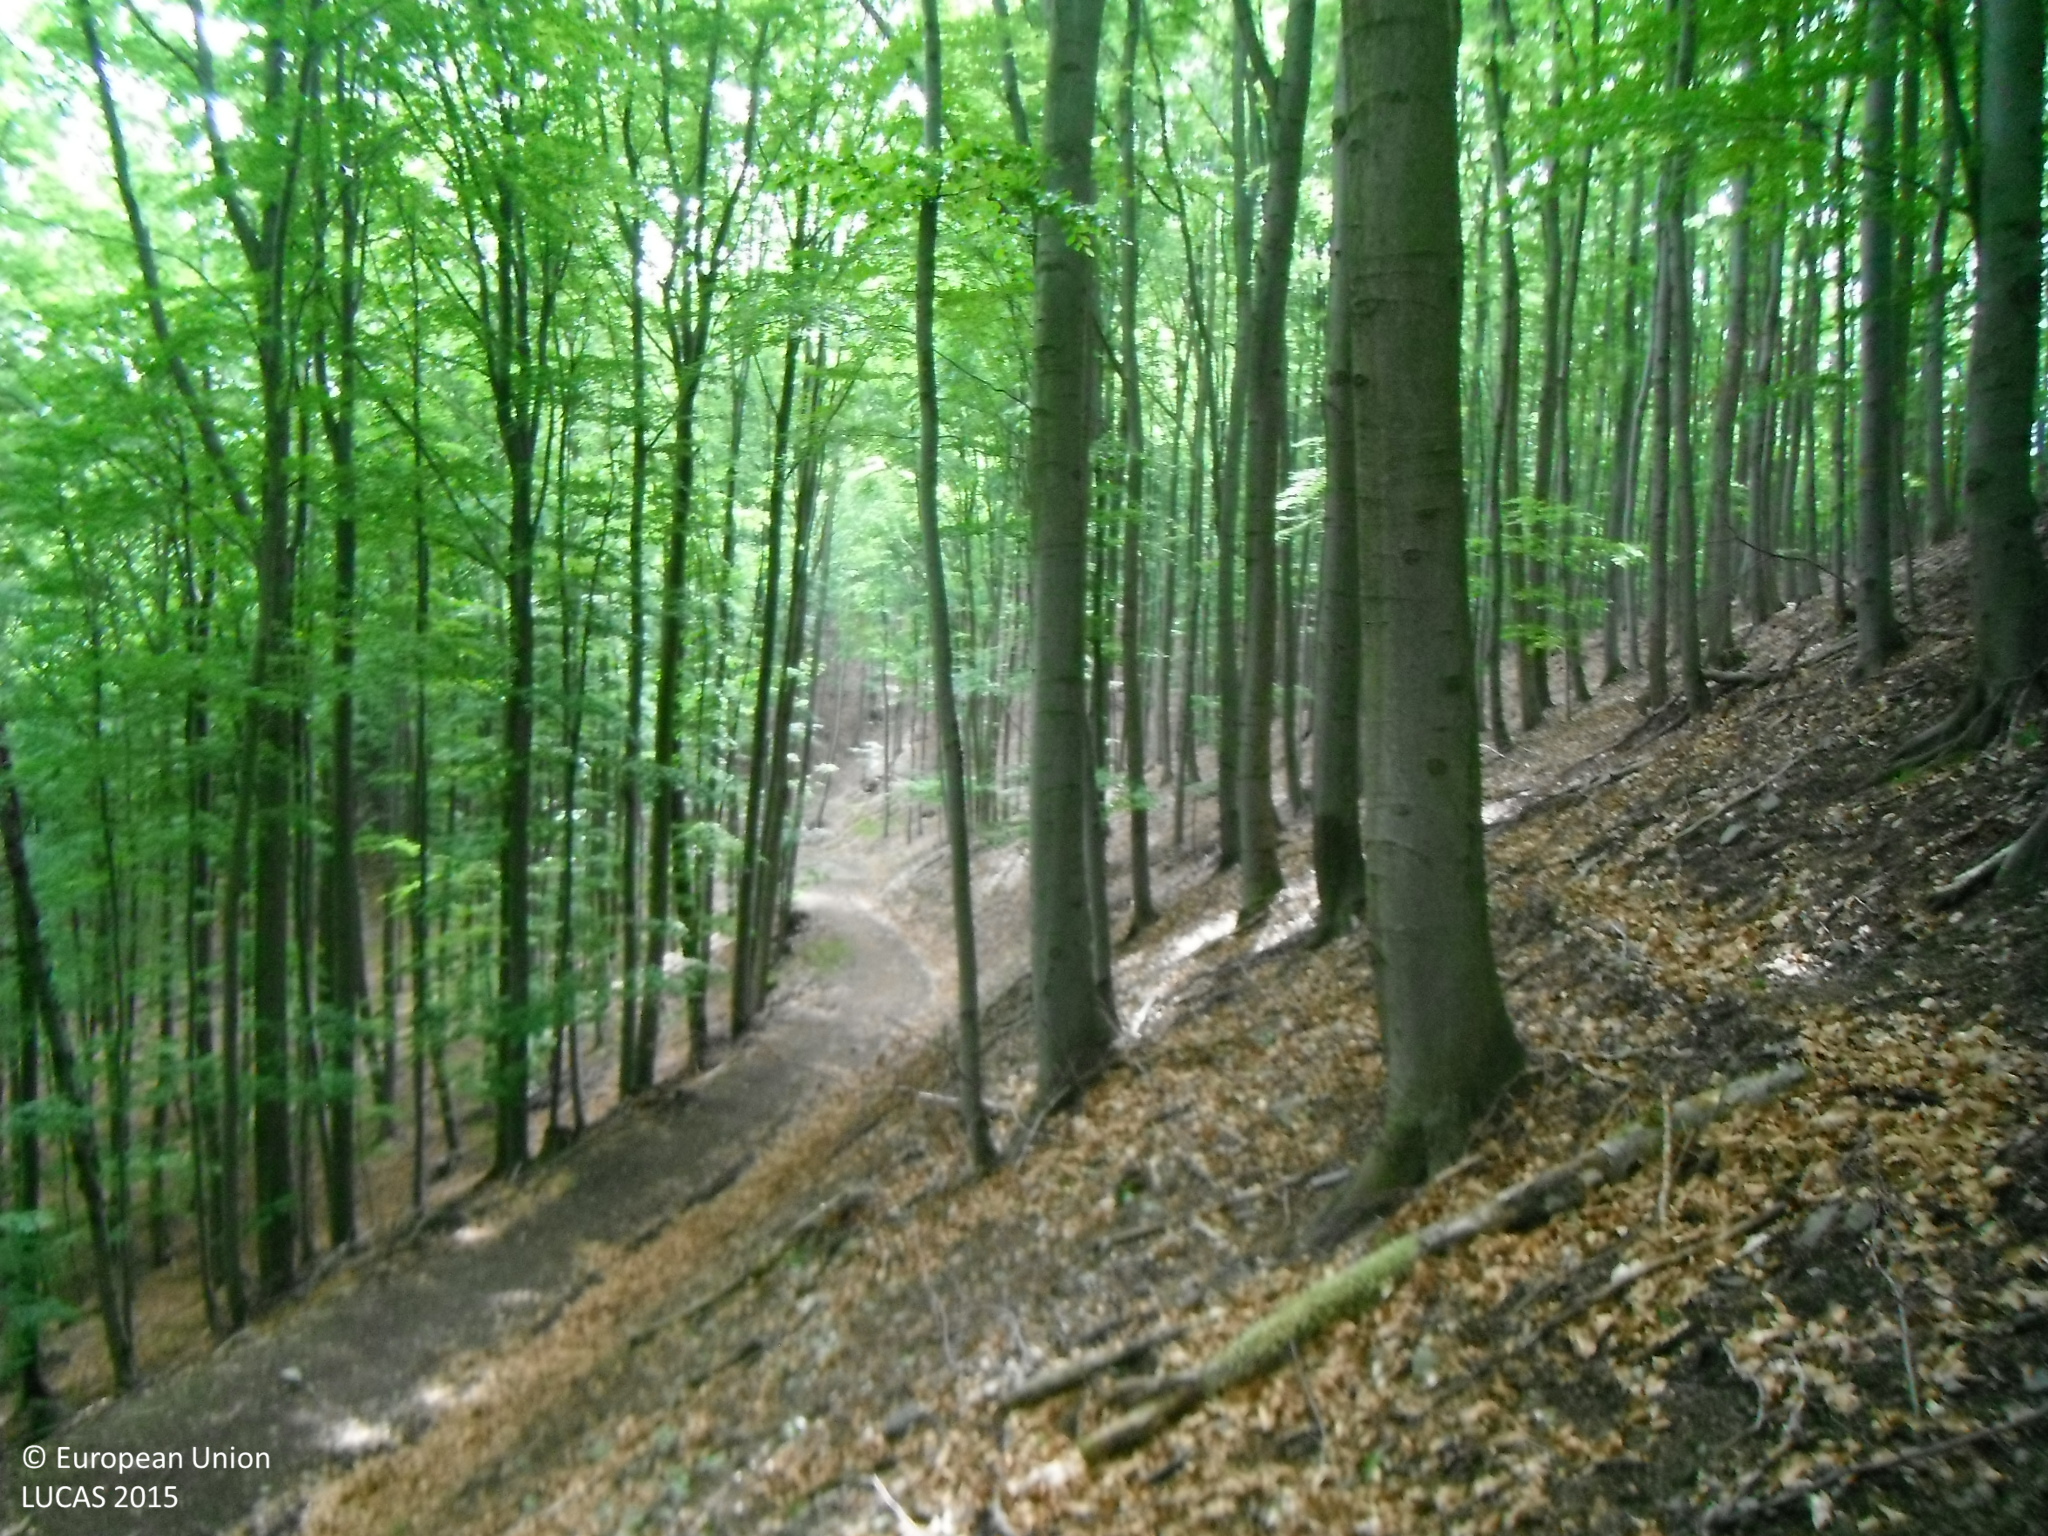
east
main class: Woodland
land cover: Broadleaved woodland
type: mountainous beech forest
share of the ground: > 75 %
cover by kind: broadleaved forest trees 100 %
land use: Forestry
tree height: > 5 m
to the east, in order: Broadleaved woodland; Tracks; Broadleaved woodland
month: May
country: SK
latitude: 48.4029
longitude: 17.2087
